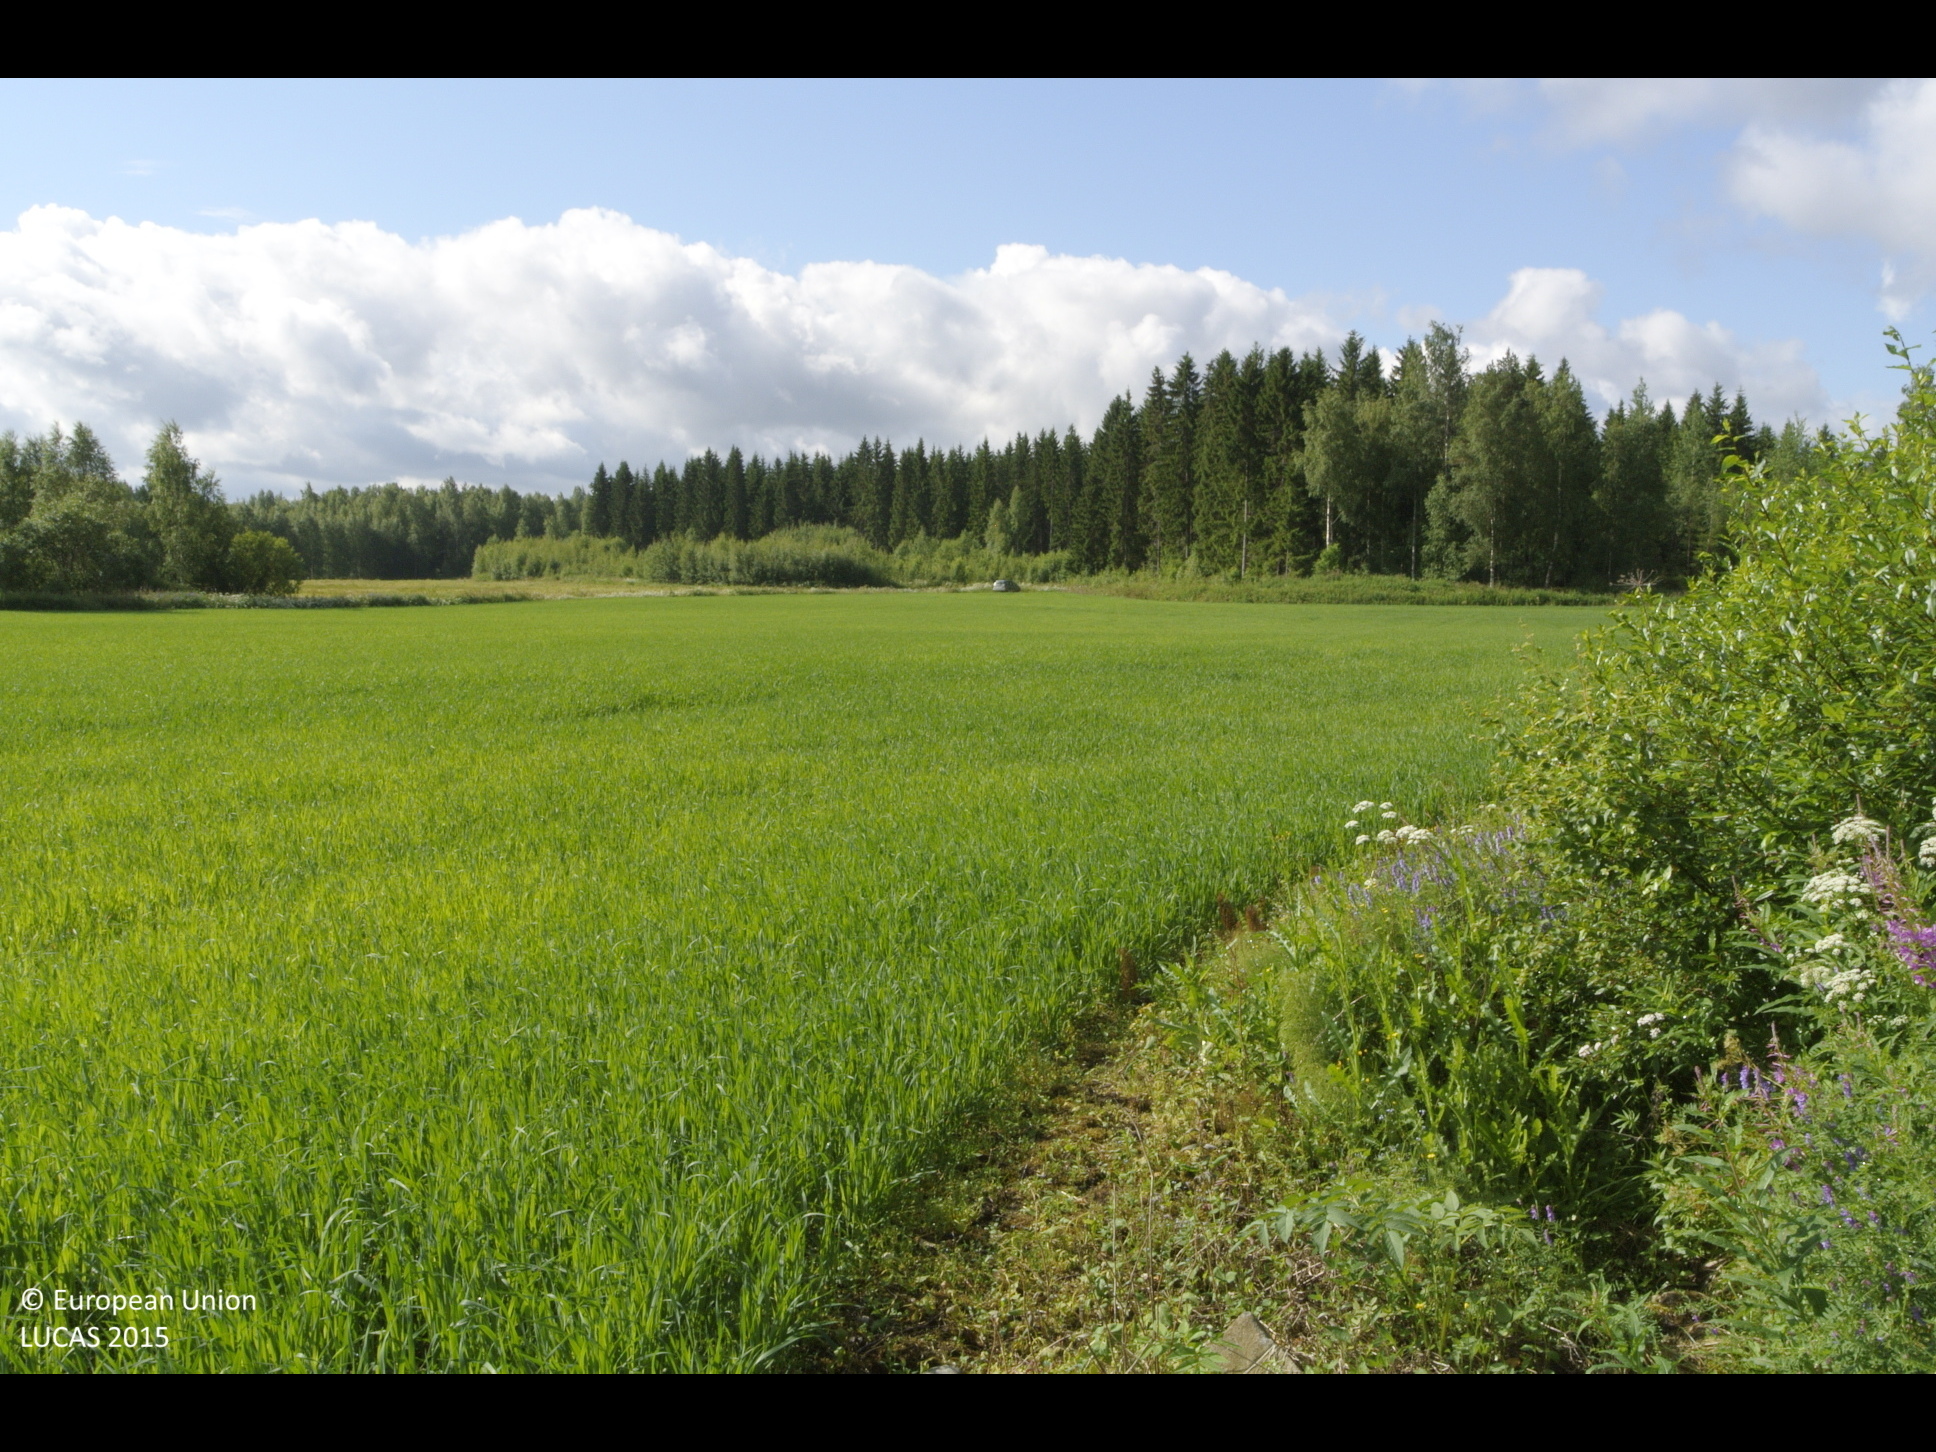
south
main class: Cropland
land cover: Oats
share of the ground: > 75 %
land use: Agriculture (excluding fallow land and kitchen gardens)
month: July
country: FI
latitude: 61.4744
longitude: 25.8030
